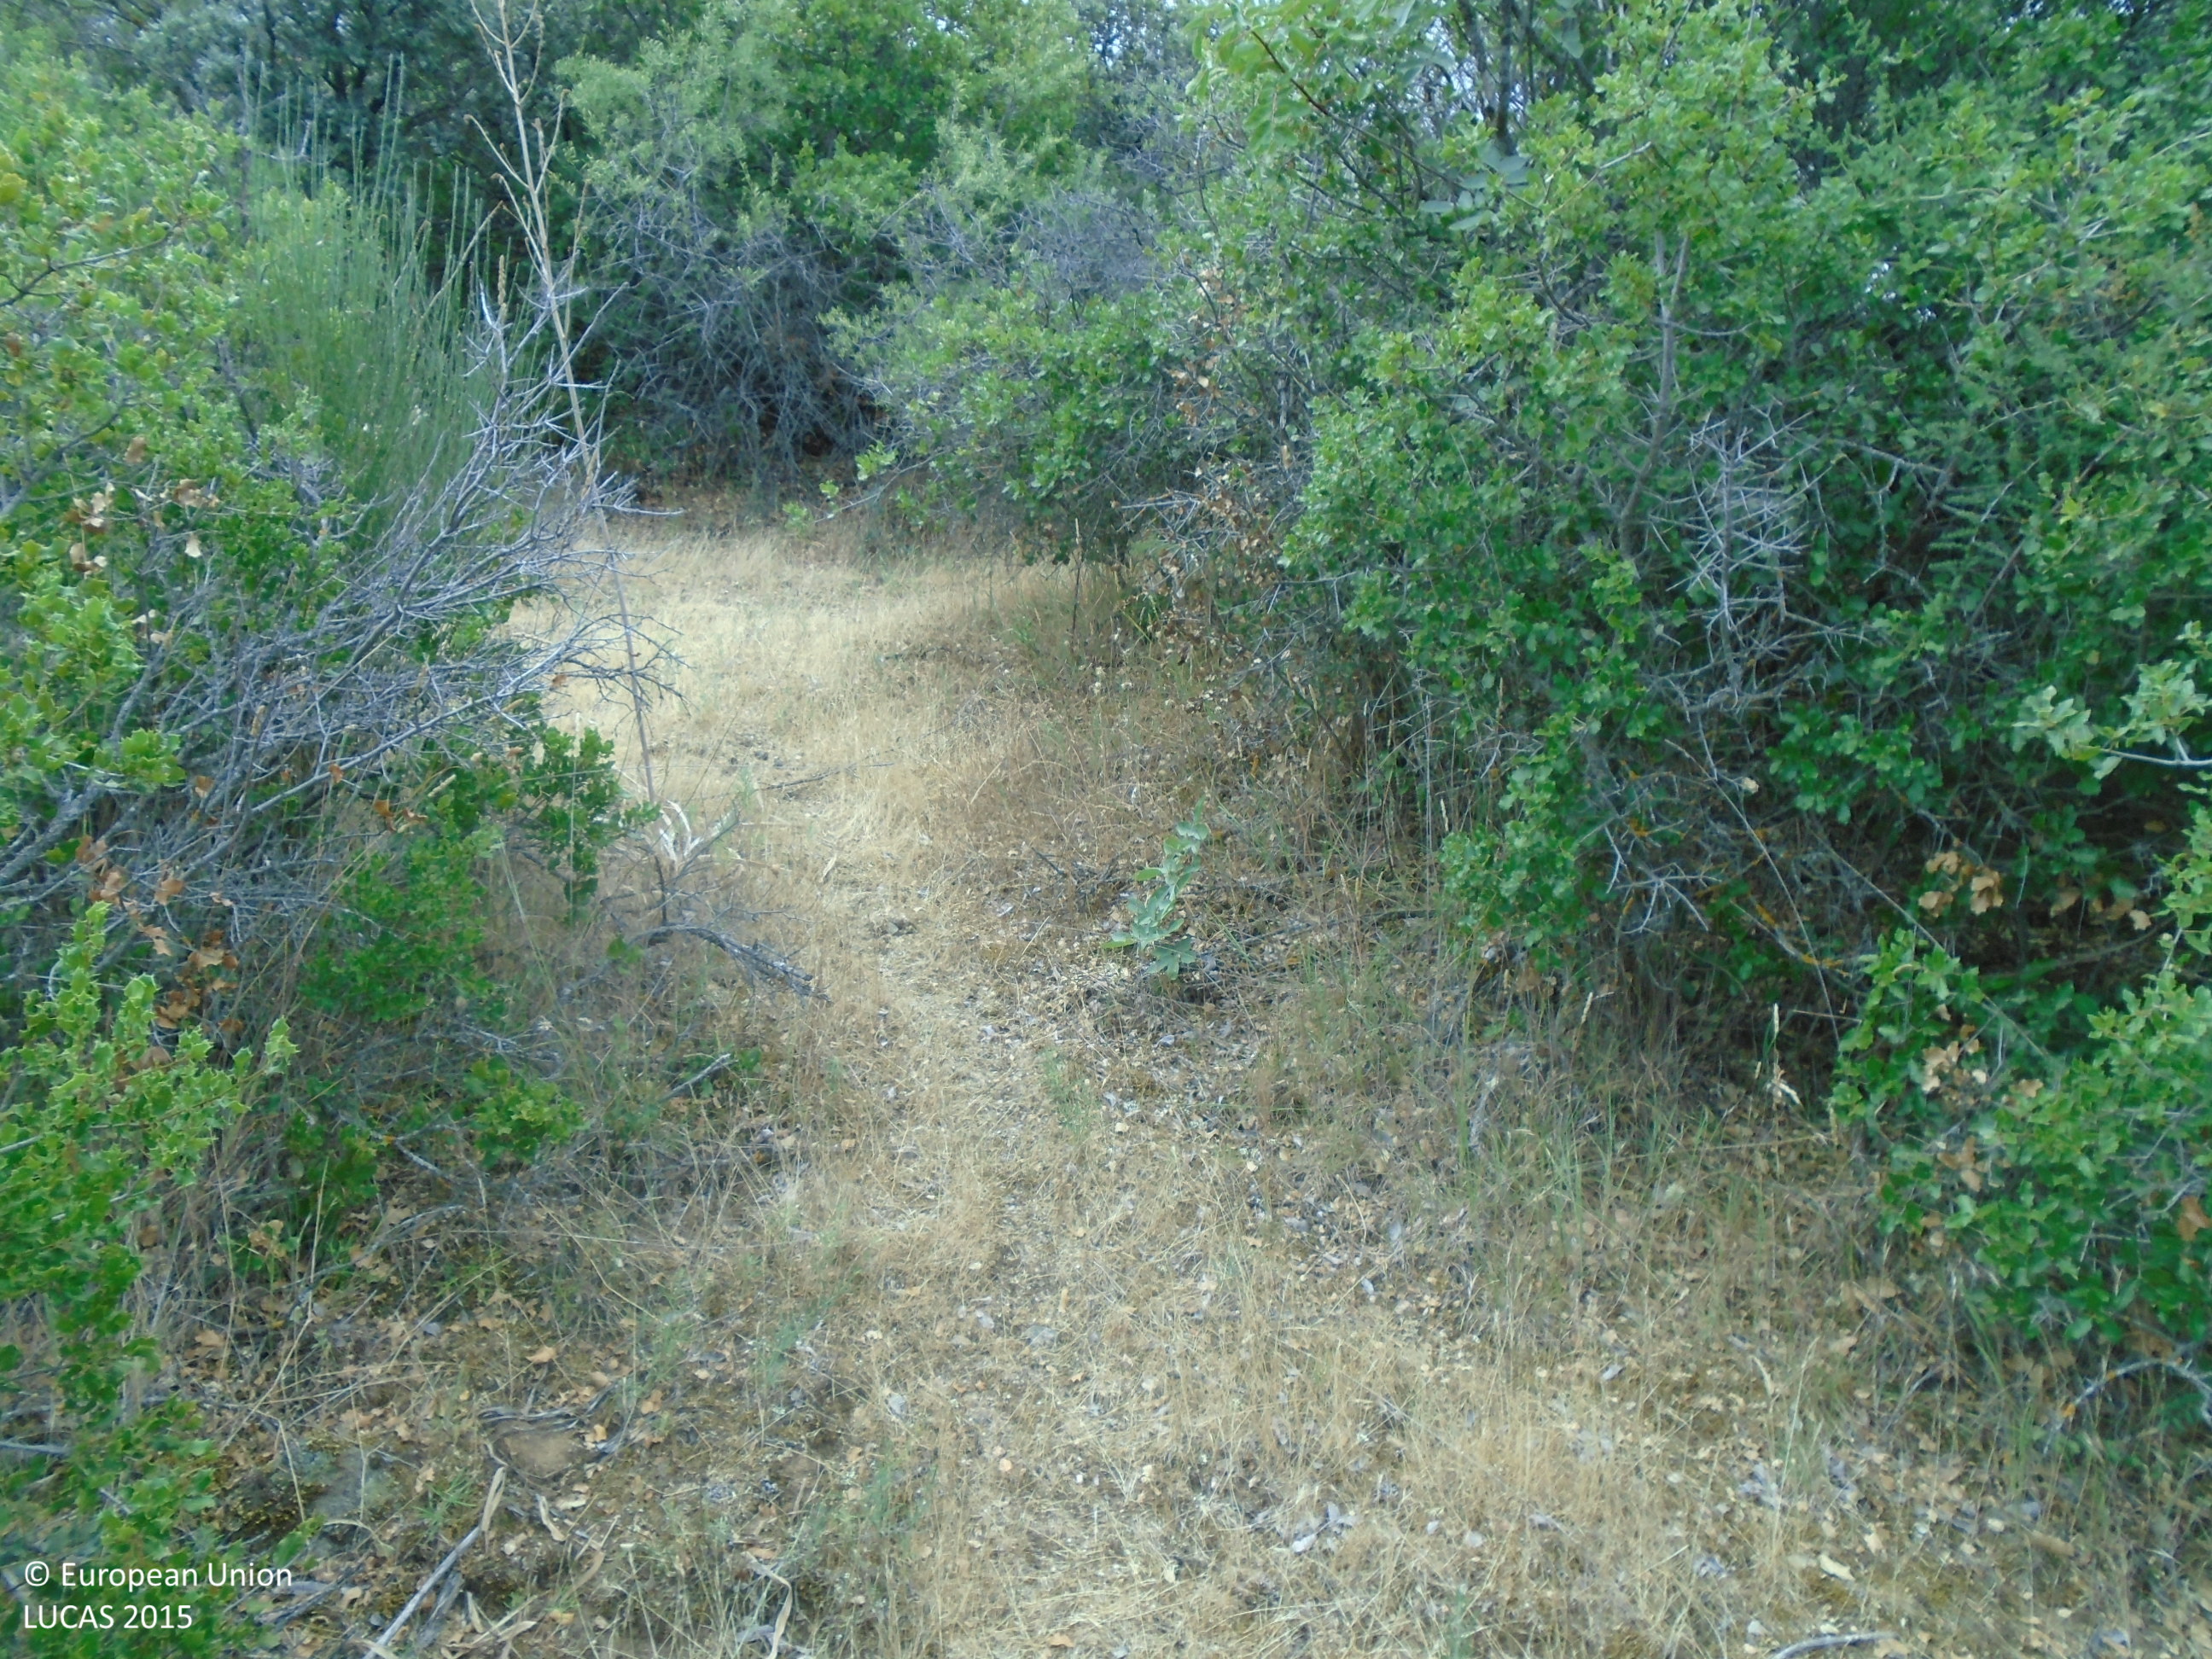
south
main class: Shrubland
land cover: Shrubland without tree cover
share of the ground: > 75 %
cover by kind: shrubs 95 %, herbaceous plants 5 %
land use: Other primary production
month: June
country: ES
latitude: 39.8180
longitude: -4.1833
